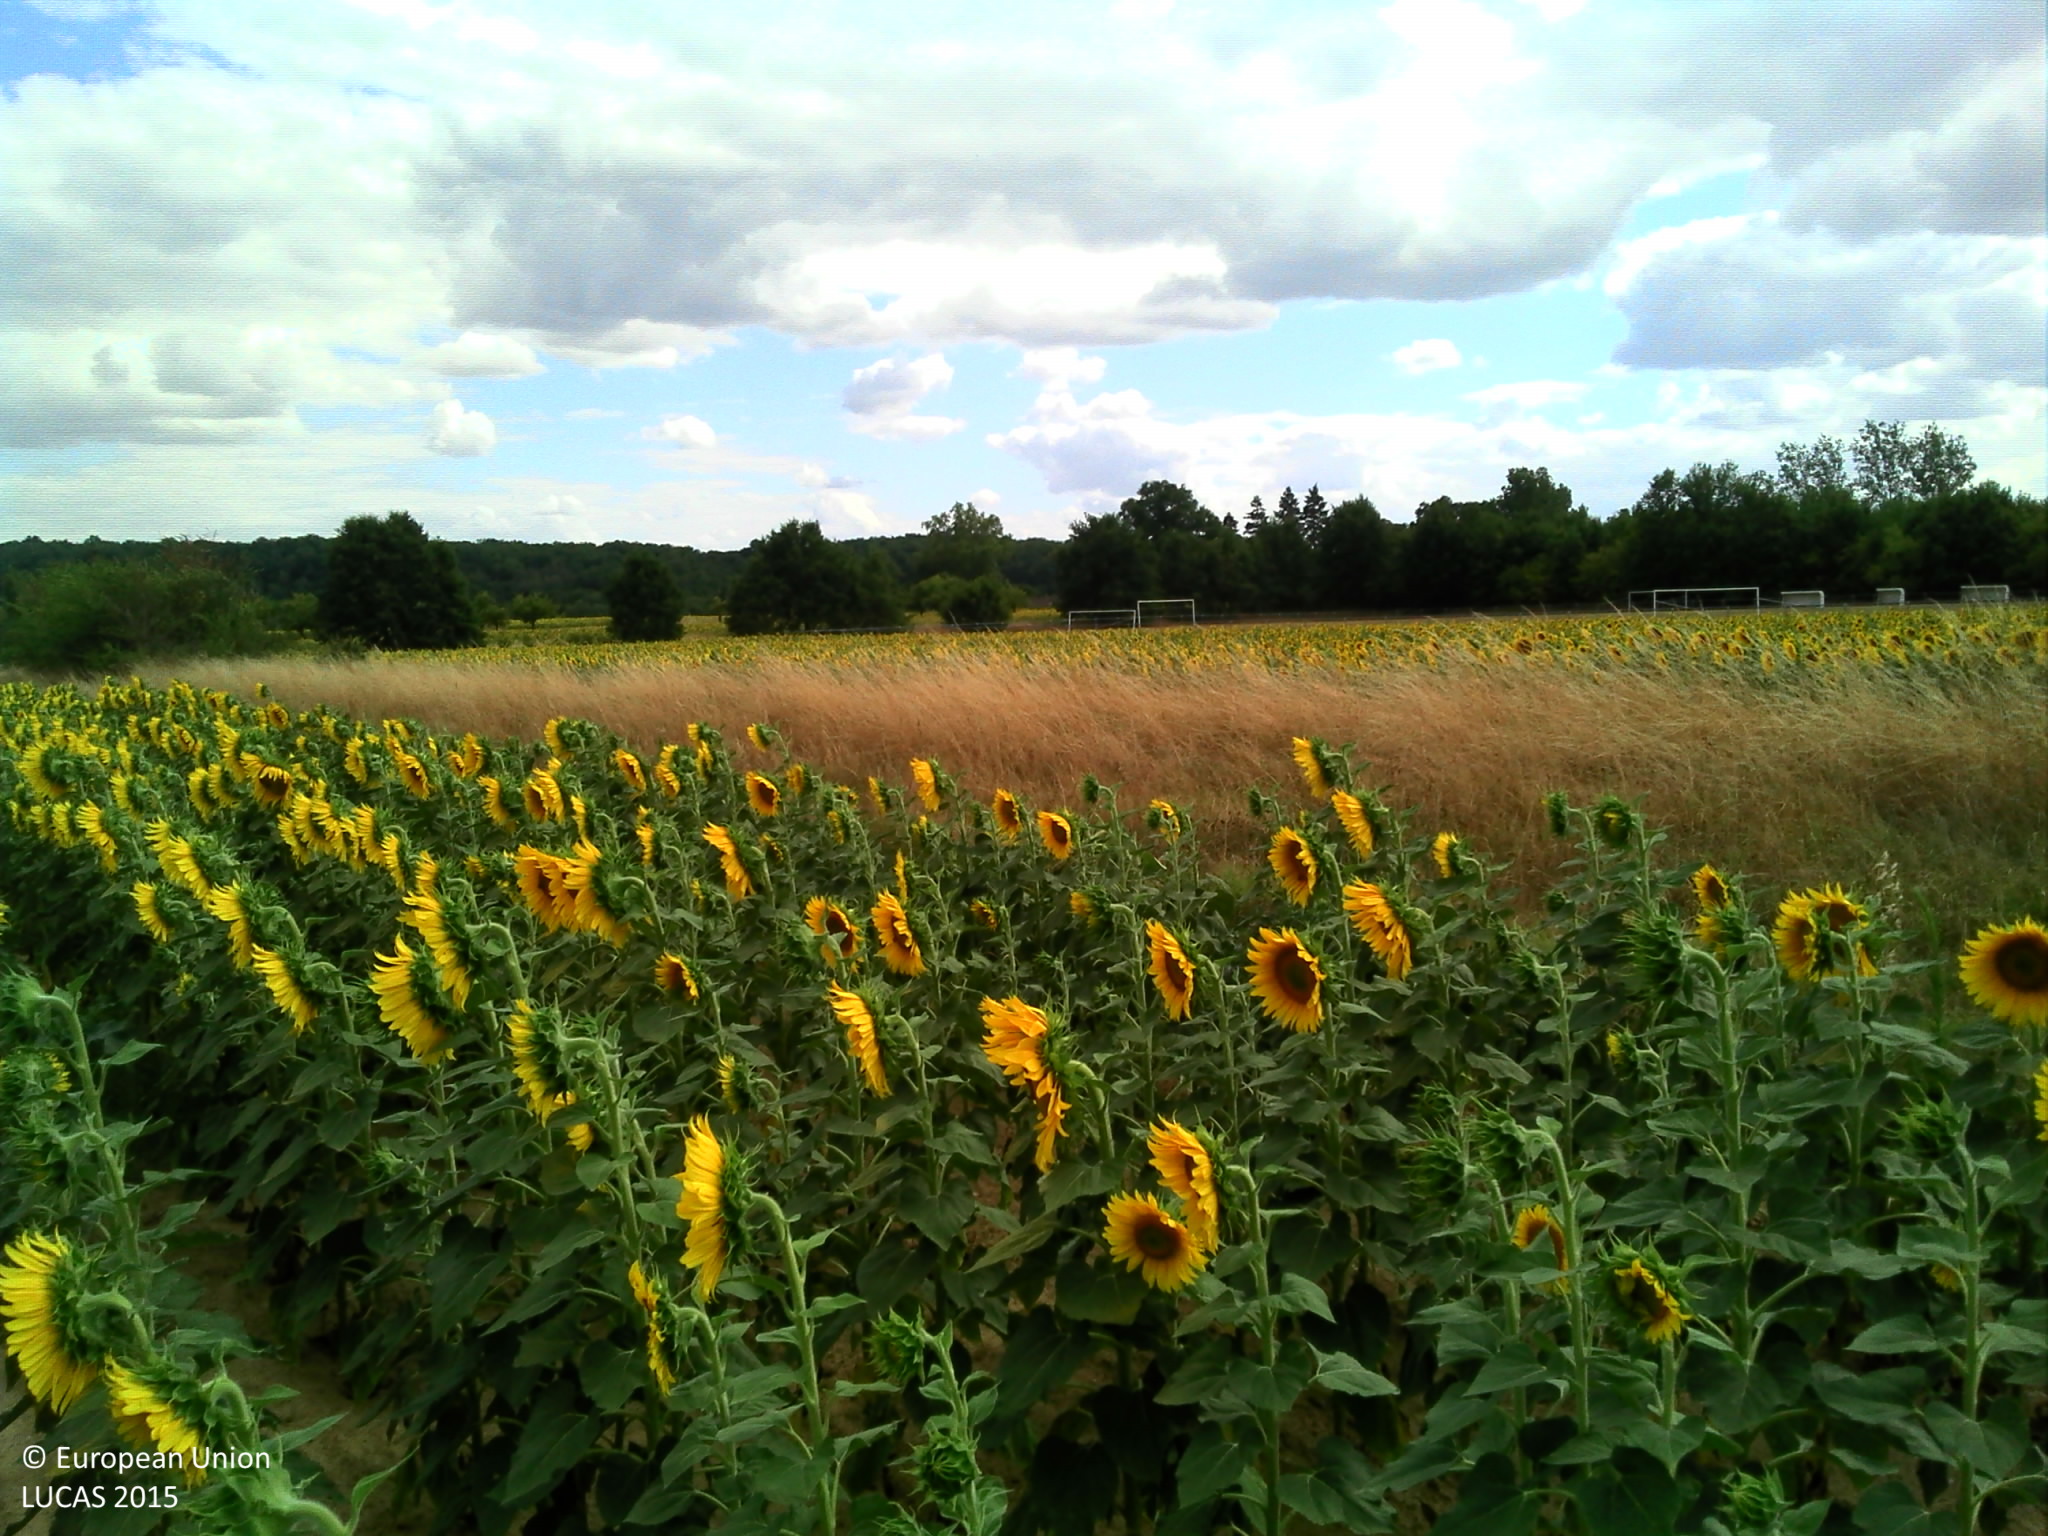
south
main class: Cropland
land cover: Sunflower
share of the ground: 50 - 75 %
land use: Agriculture (excluding fallow land and kitchen gardens)
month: July
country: FR
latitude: 44.4543
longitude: 0.6561
